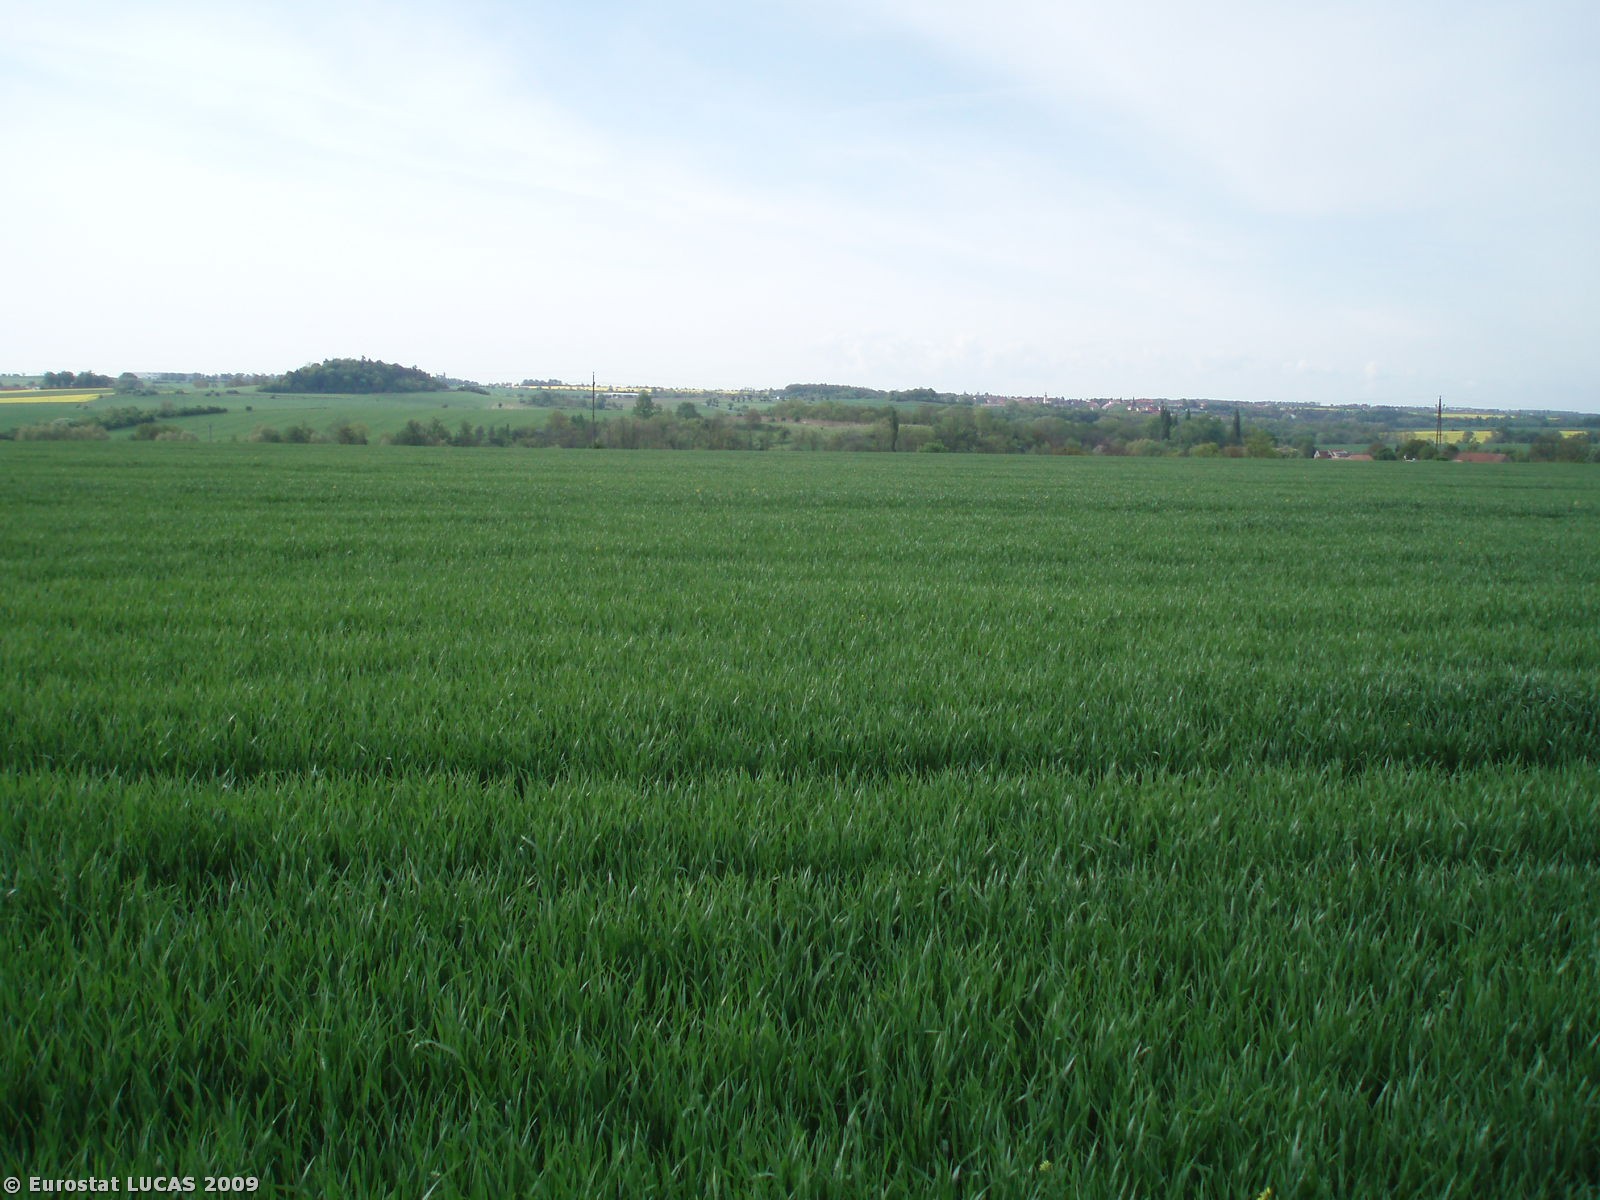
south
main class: Cropland
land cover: Common wheat
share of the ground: > 75 %
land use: Agriculture (excluding fallow land and kitchen gardens)
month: May
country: CZ
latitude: 50.1594
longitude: 14.2425
